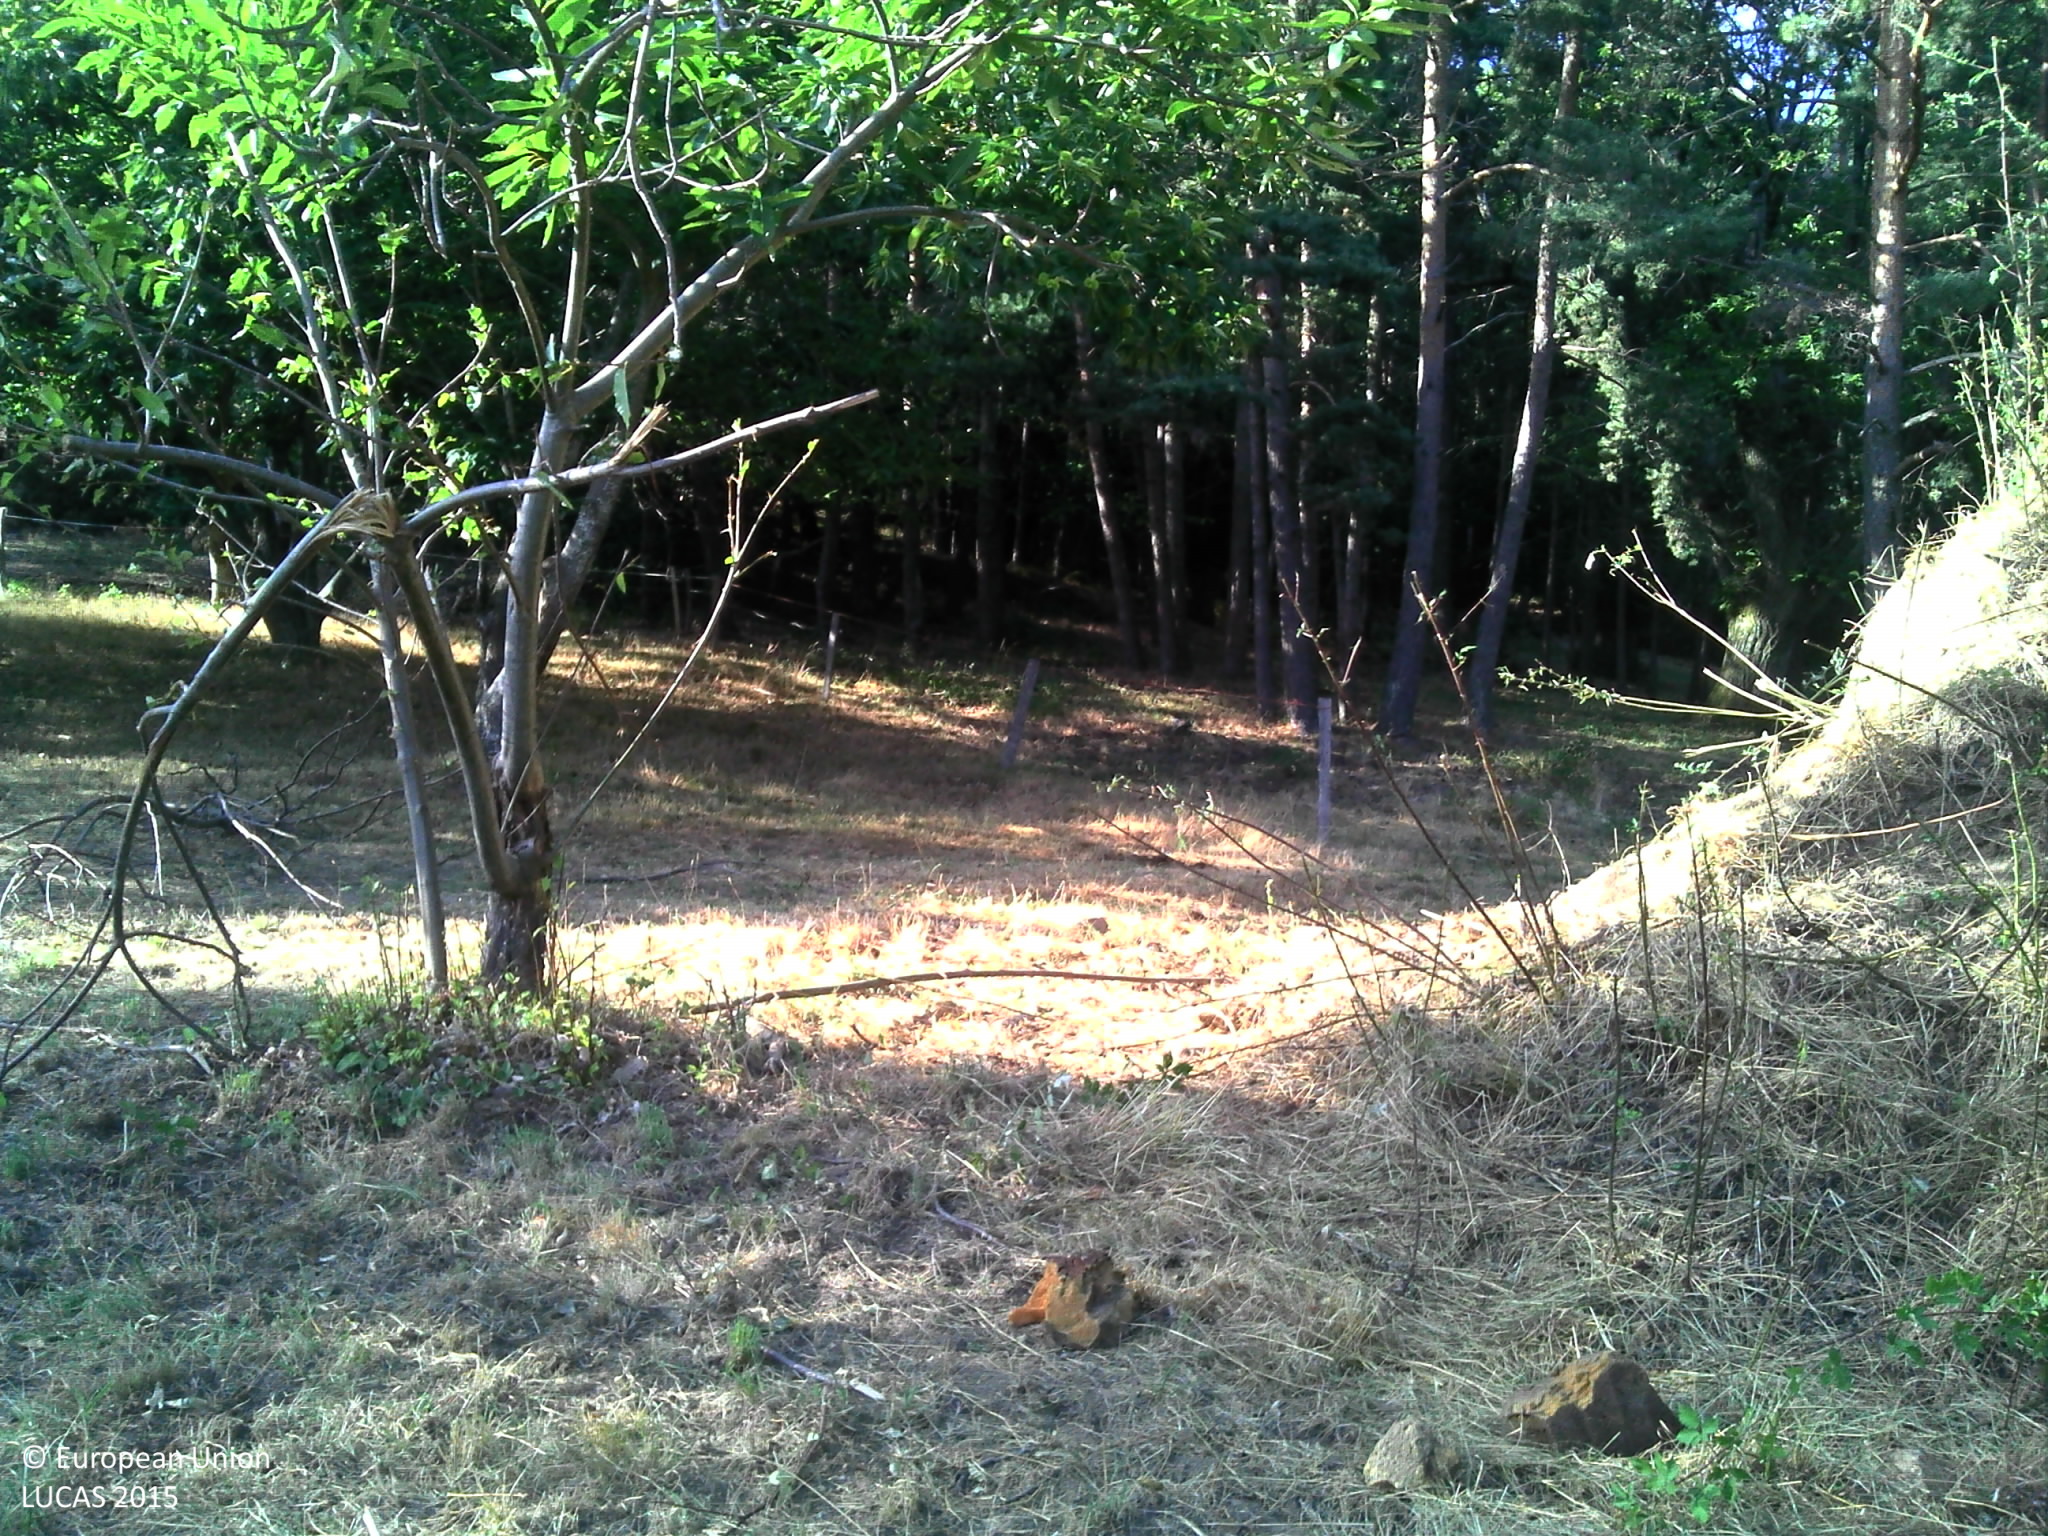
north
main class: Grassland
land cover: Grassland with sparse tree/shrub cover
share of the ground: > 75 %
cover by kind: herbaceous plants 95 %, broadleaved forest trees 5 %
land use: Agriculture (excluding fallow land and kitchen gardens)
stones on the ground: < 10 %
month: July
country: FR
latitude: 44.9338
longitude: 4.6202
